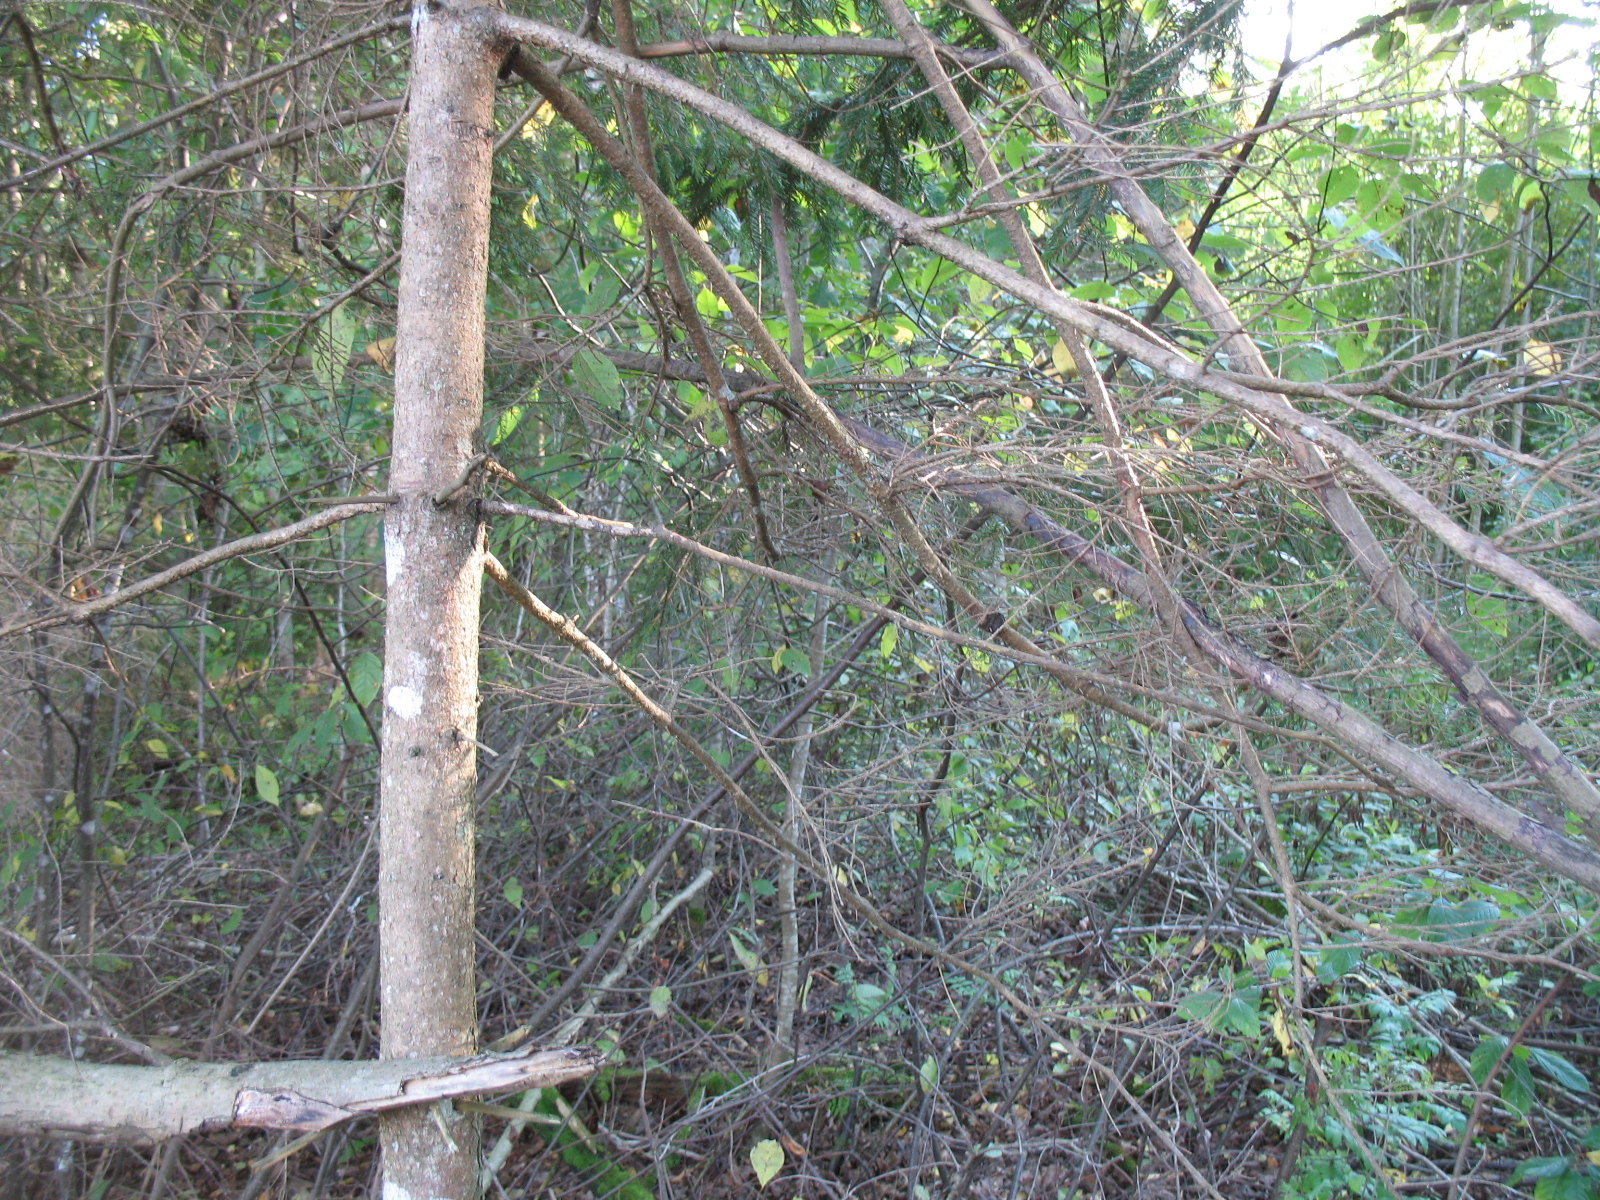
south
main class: Woodland
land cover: Spruce dominated mixed woodland
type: hemiboreal forest and nemoral coniferous forest and mixed broadleaved-coniferous forest
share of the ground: > 75 %
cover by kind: broadleaved forest trees 55 %, coniferous forest trees 25 %, shrubs 10 %, herbaceous plants 10 %
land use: Forestry
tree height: > 5 m
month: September
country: LV
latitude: 56.1396
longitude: 25.9201
